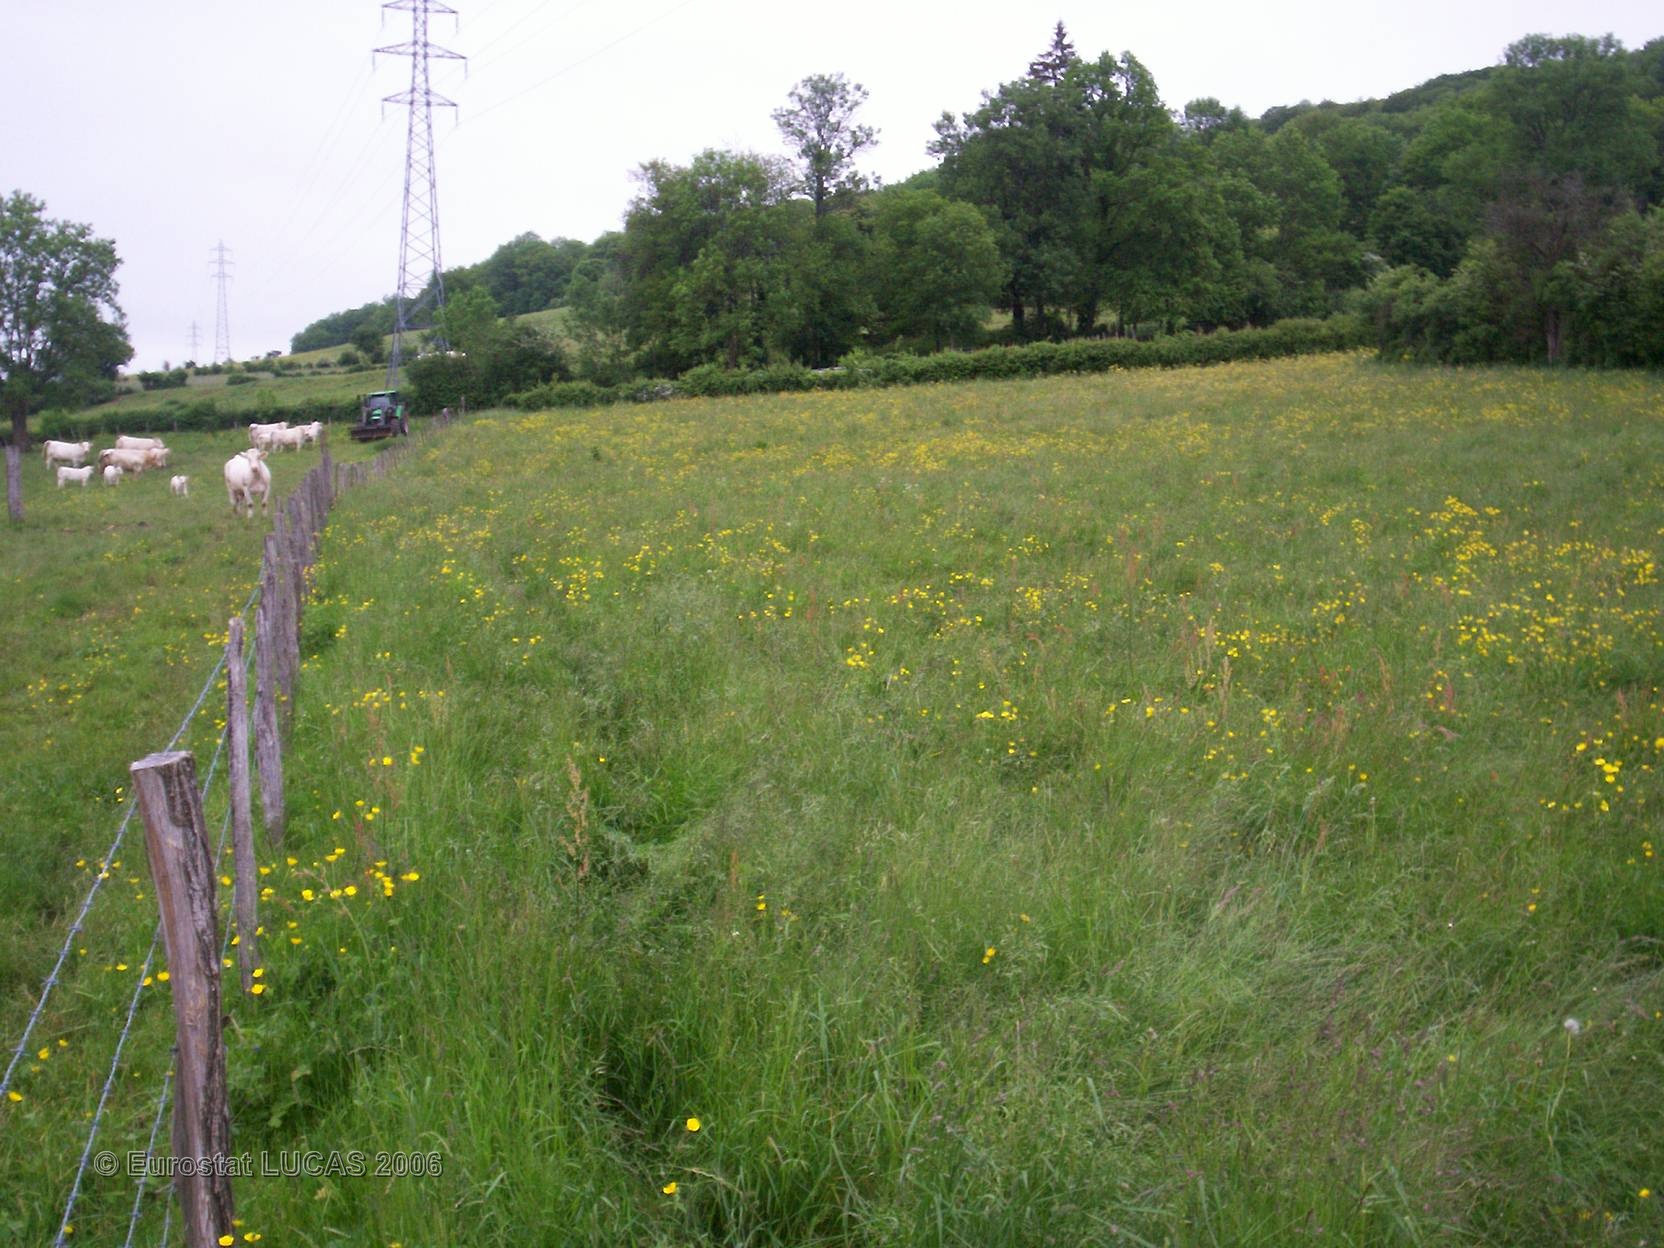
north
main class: Grassland
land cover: Grassland without tree/shrub cover
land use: Agriculture (excluding fallow land and kitchen gardens)
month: May
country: FR
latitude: 47.3728
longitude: 4.6626
